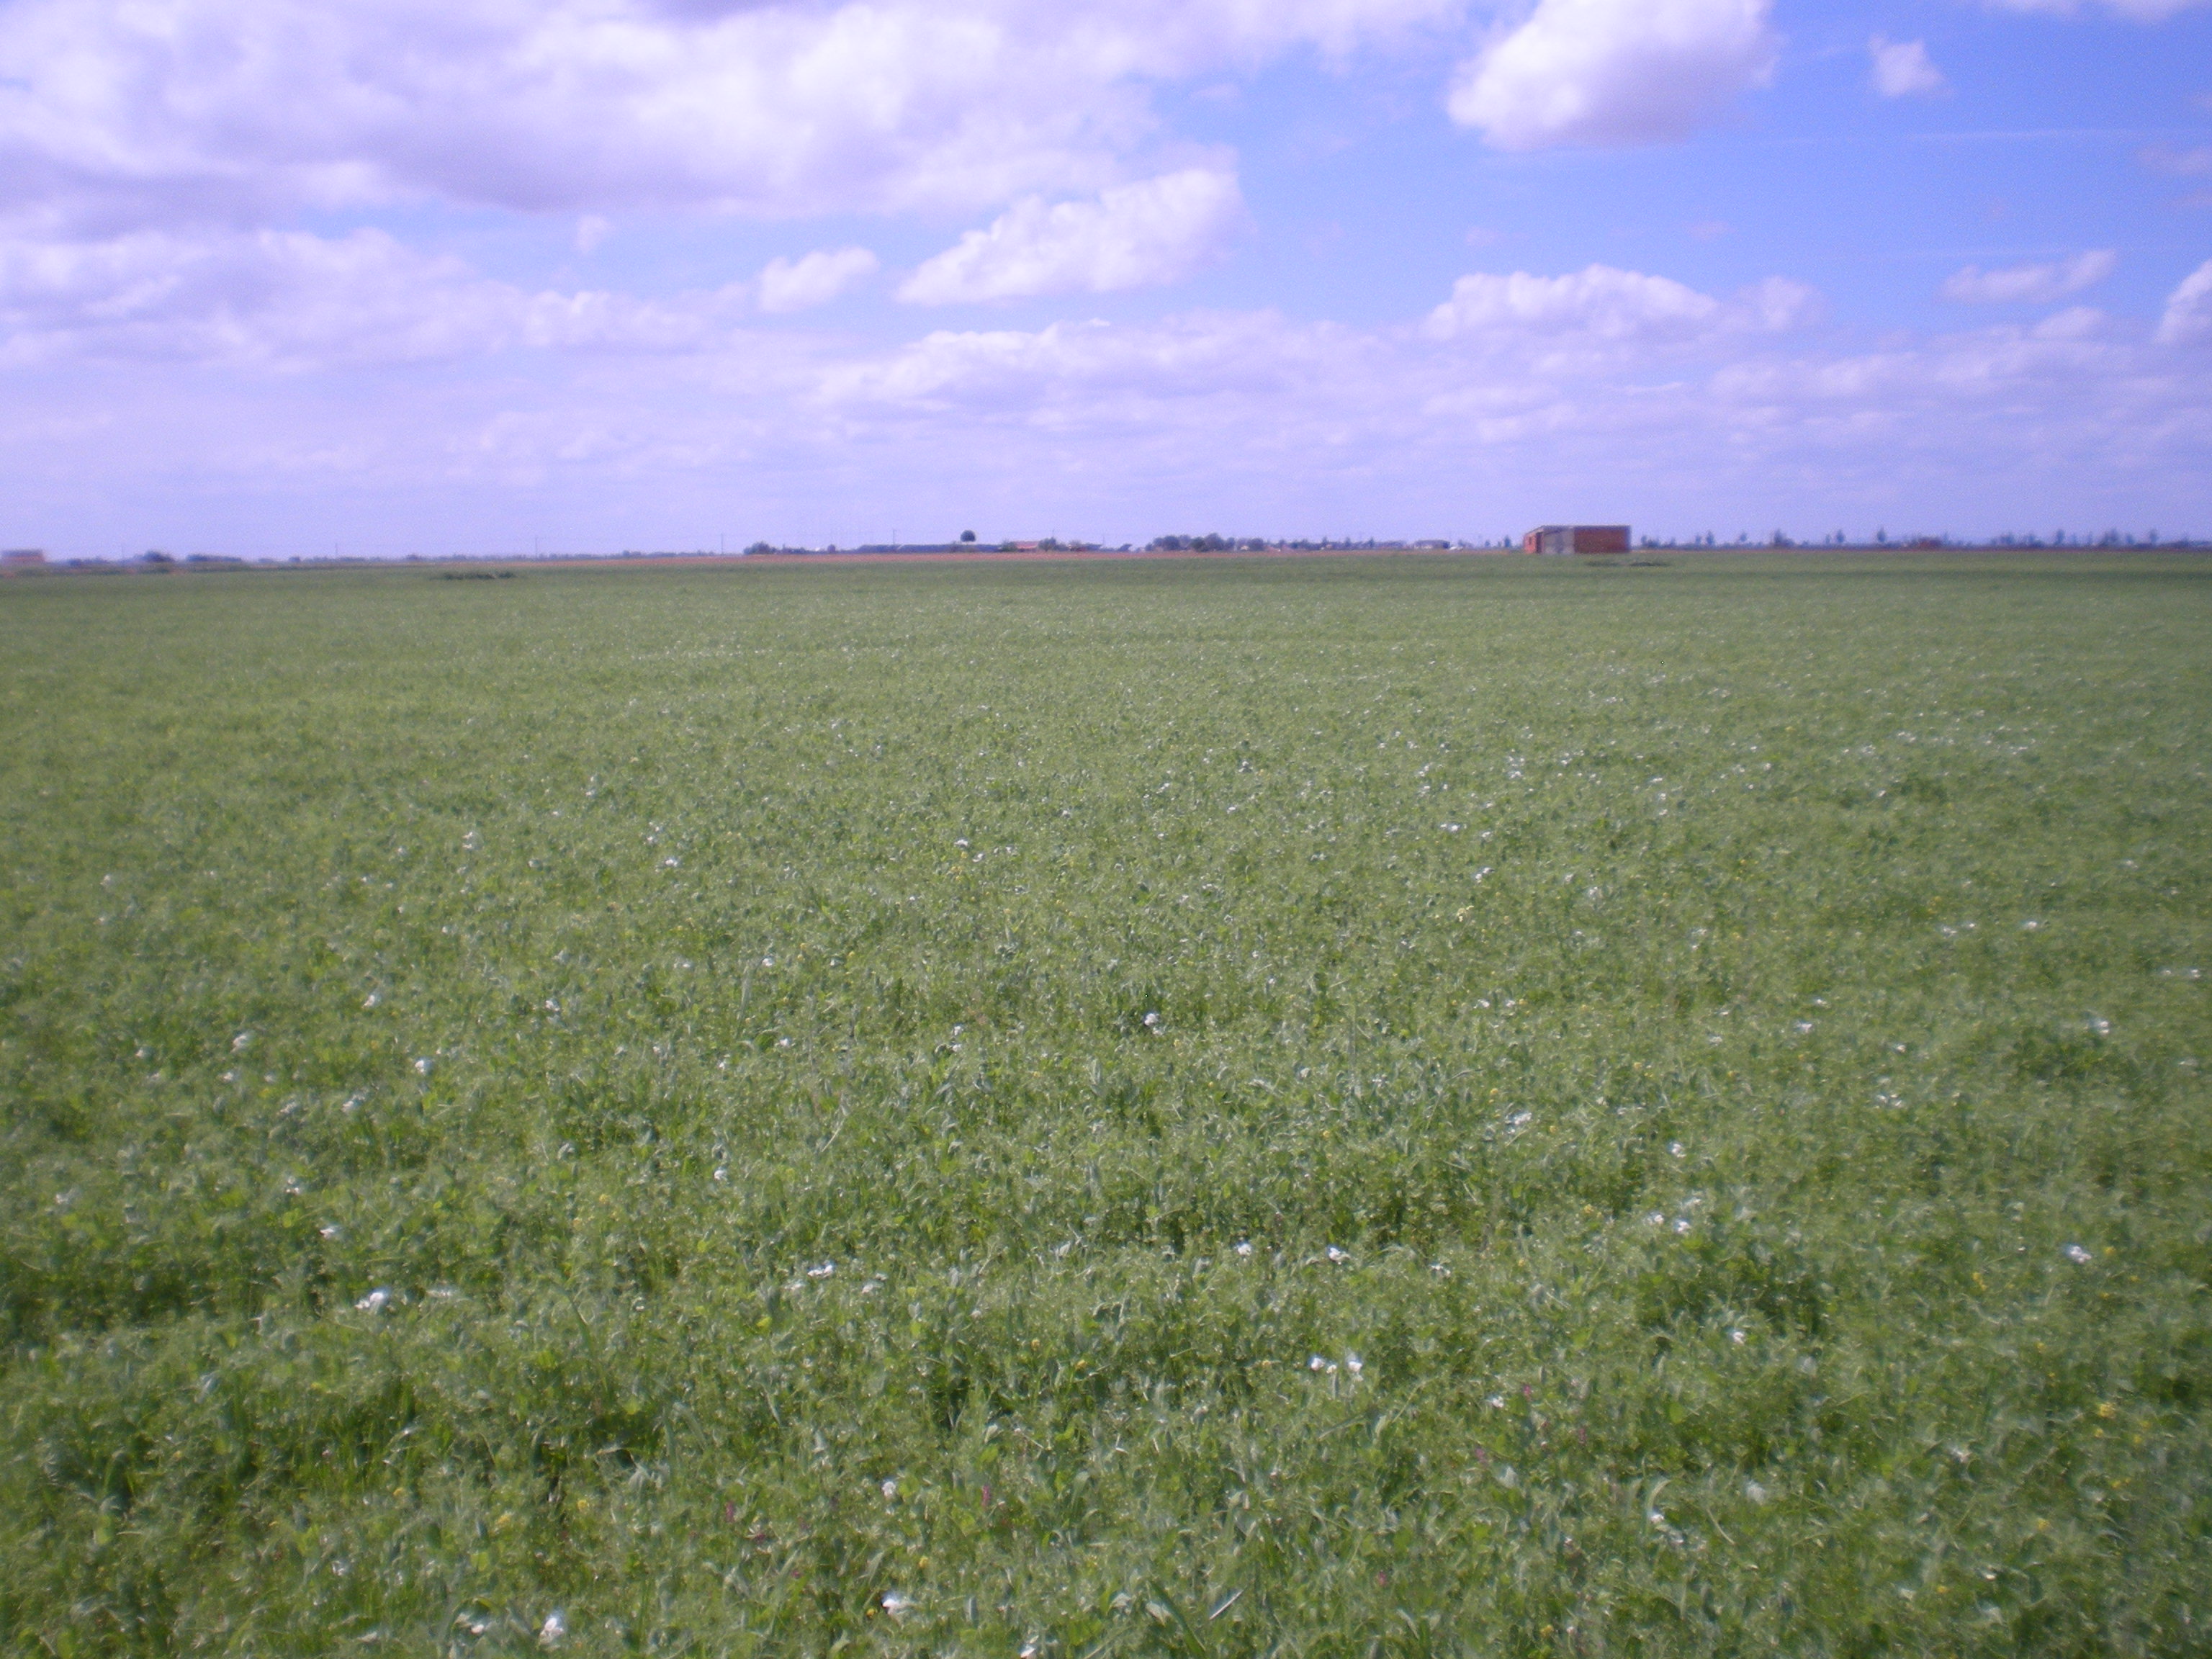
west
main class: Cropland
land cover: Other fresh vegetables
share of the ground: 50 - 75 %
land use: Agriculture (excluding fallow land and kitchen gardens)
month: April
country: ES
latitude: 38.9946
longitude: -3.5361
